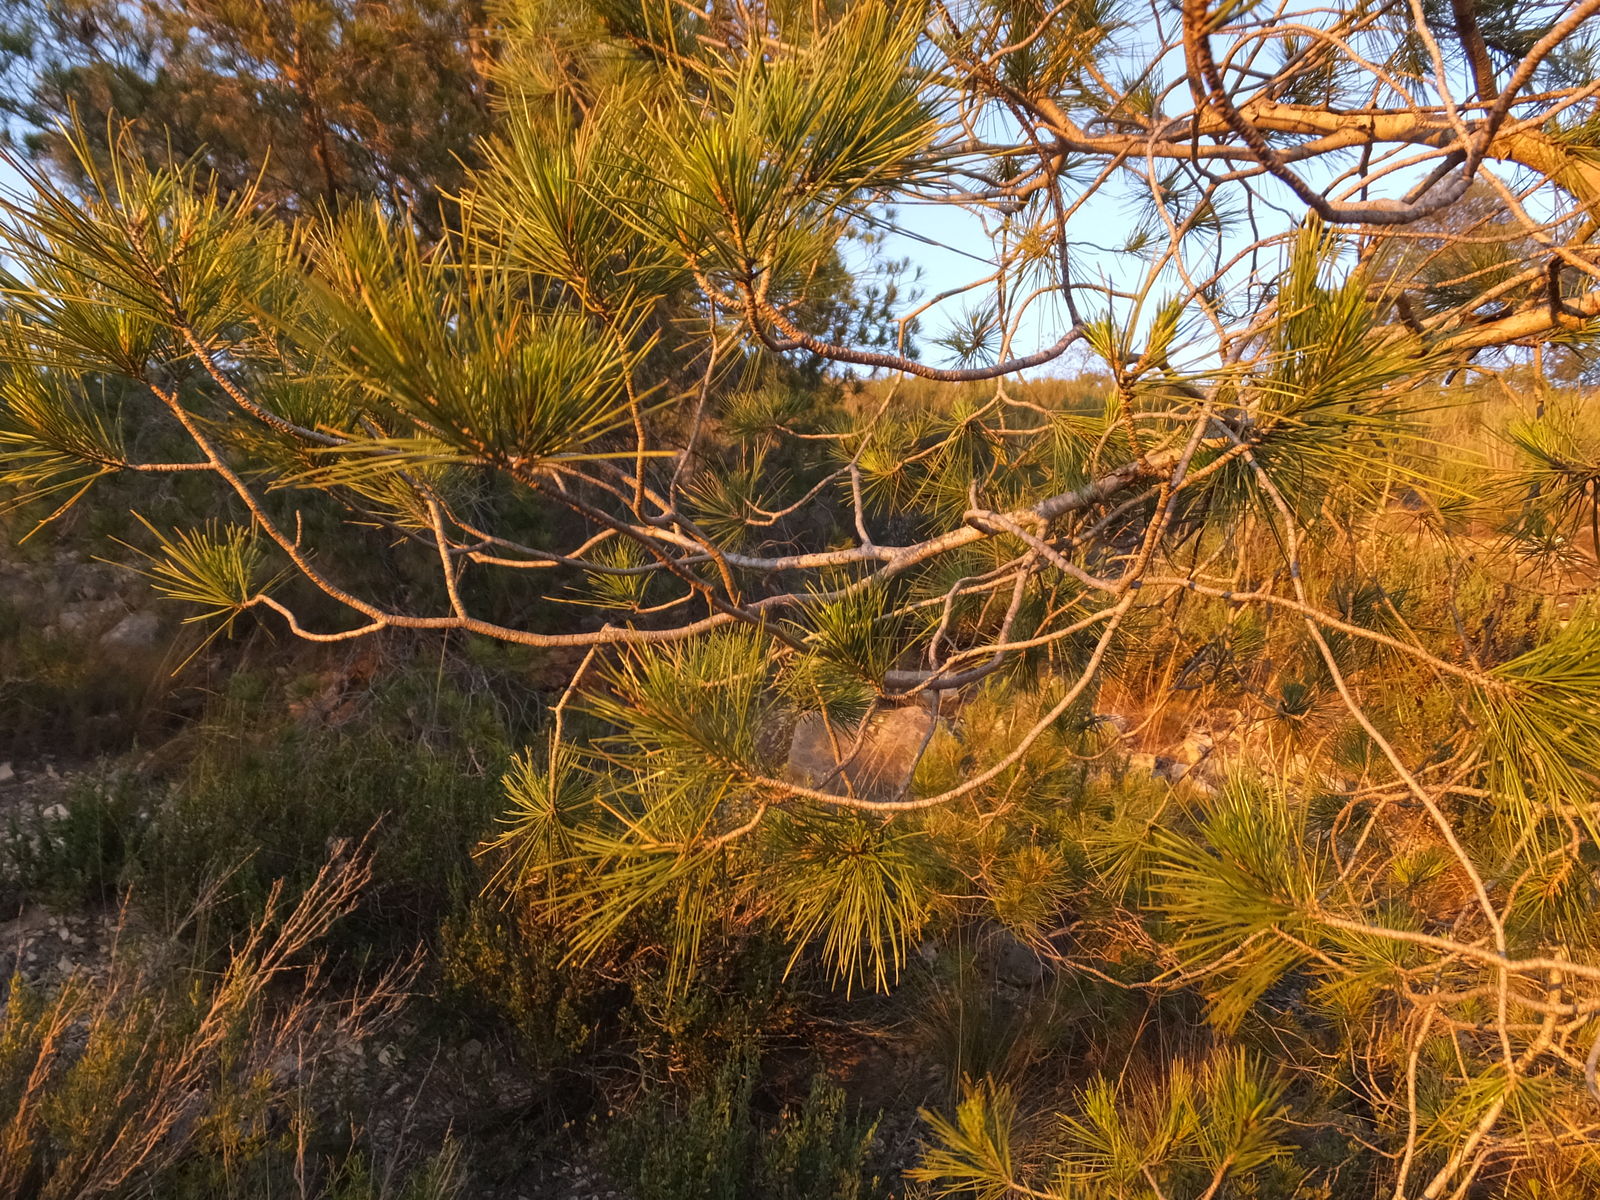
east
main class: Woodland
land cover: Pine dominated mixed woodland
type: coniferous forest of the mediterranean region
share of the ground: 25 - 50 %
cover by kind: shrubs 50 %, coniferous forest trees 25 %, broadleaved forest trees 15 %, herbaceous plants 10 %
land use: Forestry
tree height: < 5 m
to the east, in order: Pine dominated mixed woodland
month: June
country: ES
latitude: 41.3494
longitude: -0.2575
